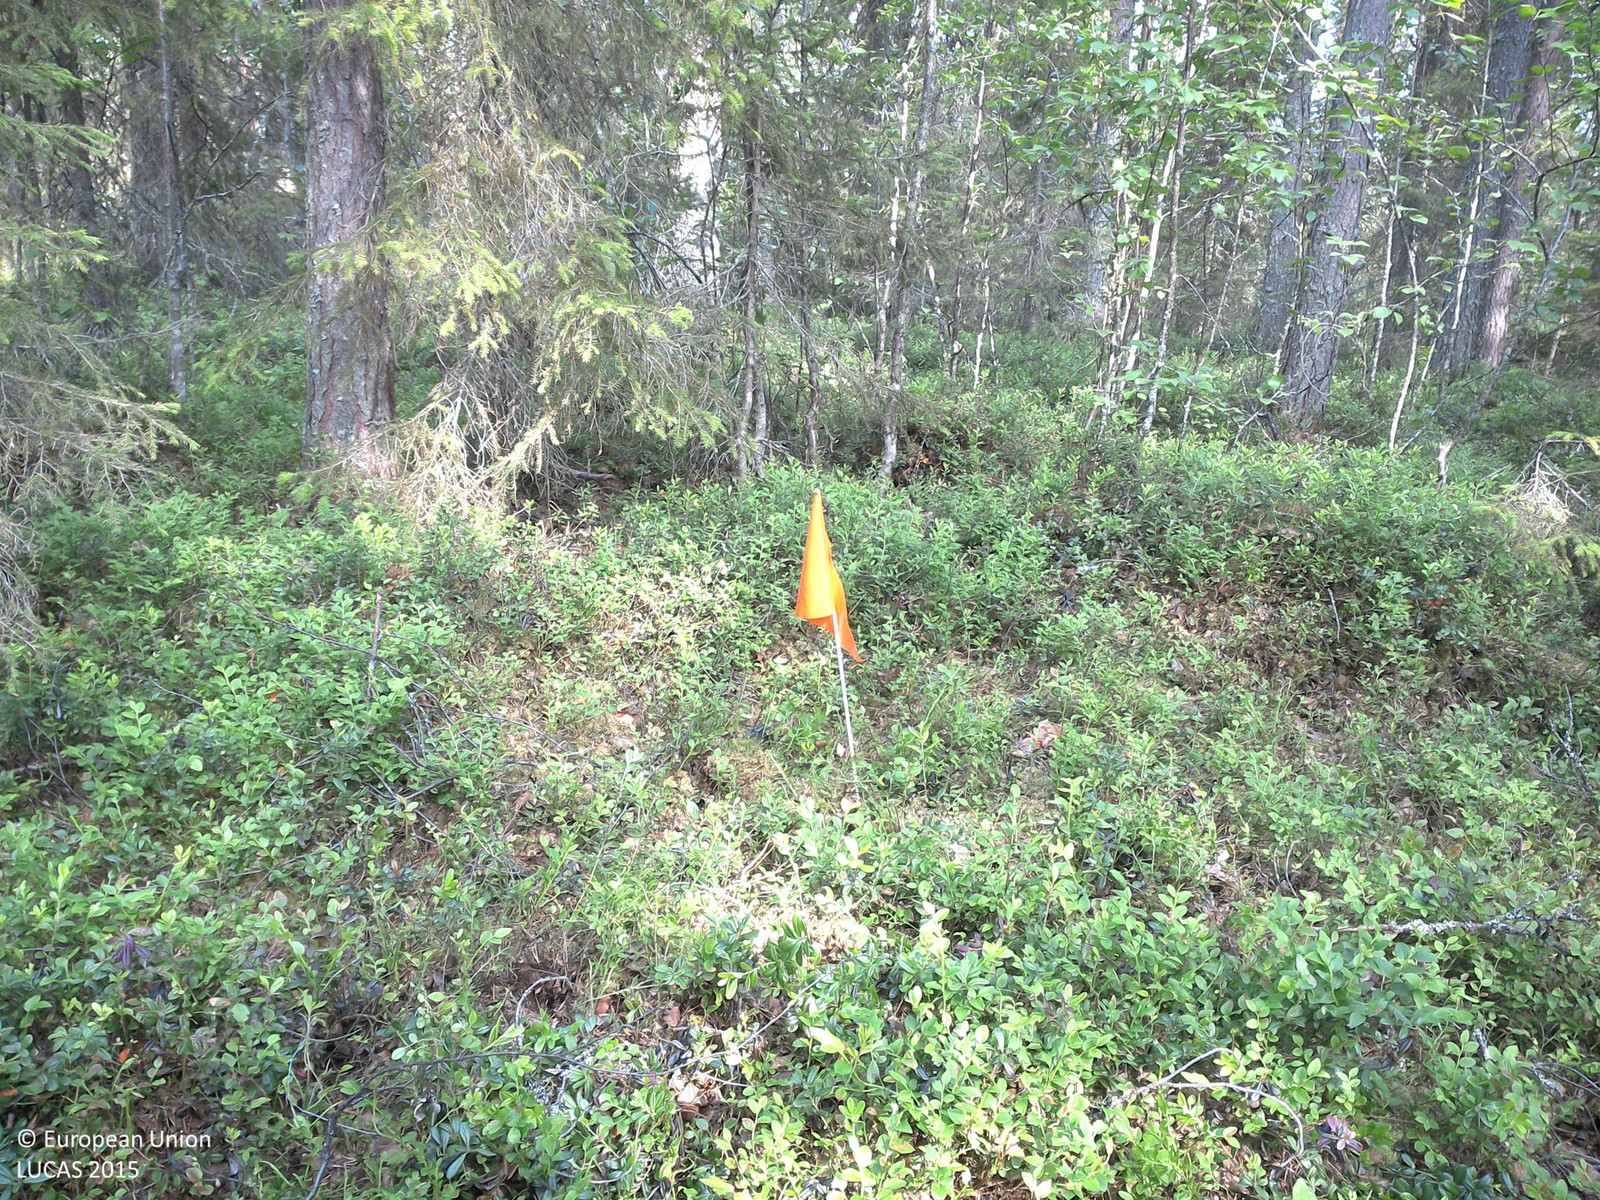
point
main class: Woodland
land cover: Pine dominated mixed woodland
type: boreal forest
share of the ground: 25 - 50 %
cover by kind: shrubs 55 %, coniferous forest trees 30 %, broadleaved forest trees 10 %, lichens and mosses 5 %
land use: Forestry
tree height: > 5 m
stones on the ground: 10 - 25 %
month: July
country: SE
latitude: 67.0129
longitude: 22.8880
